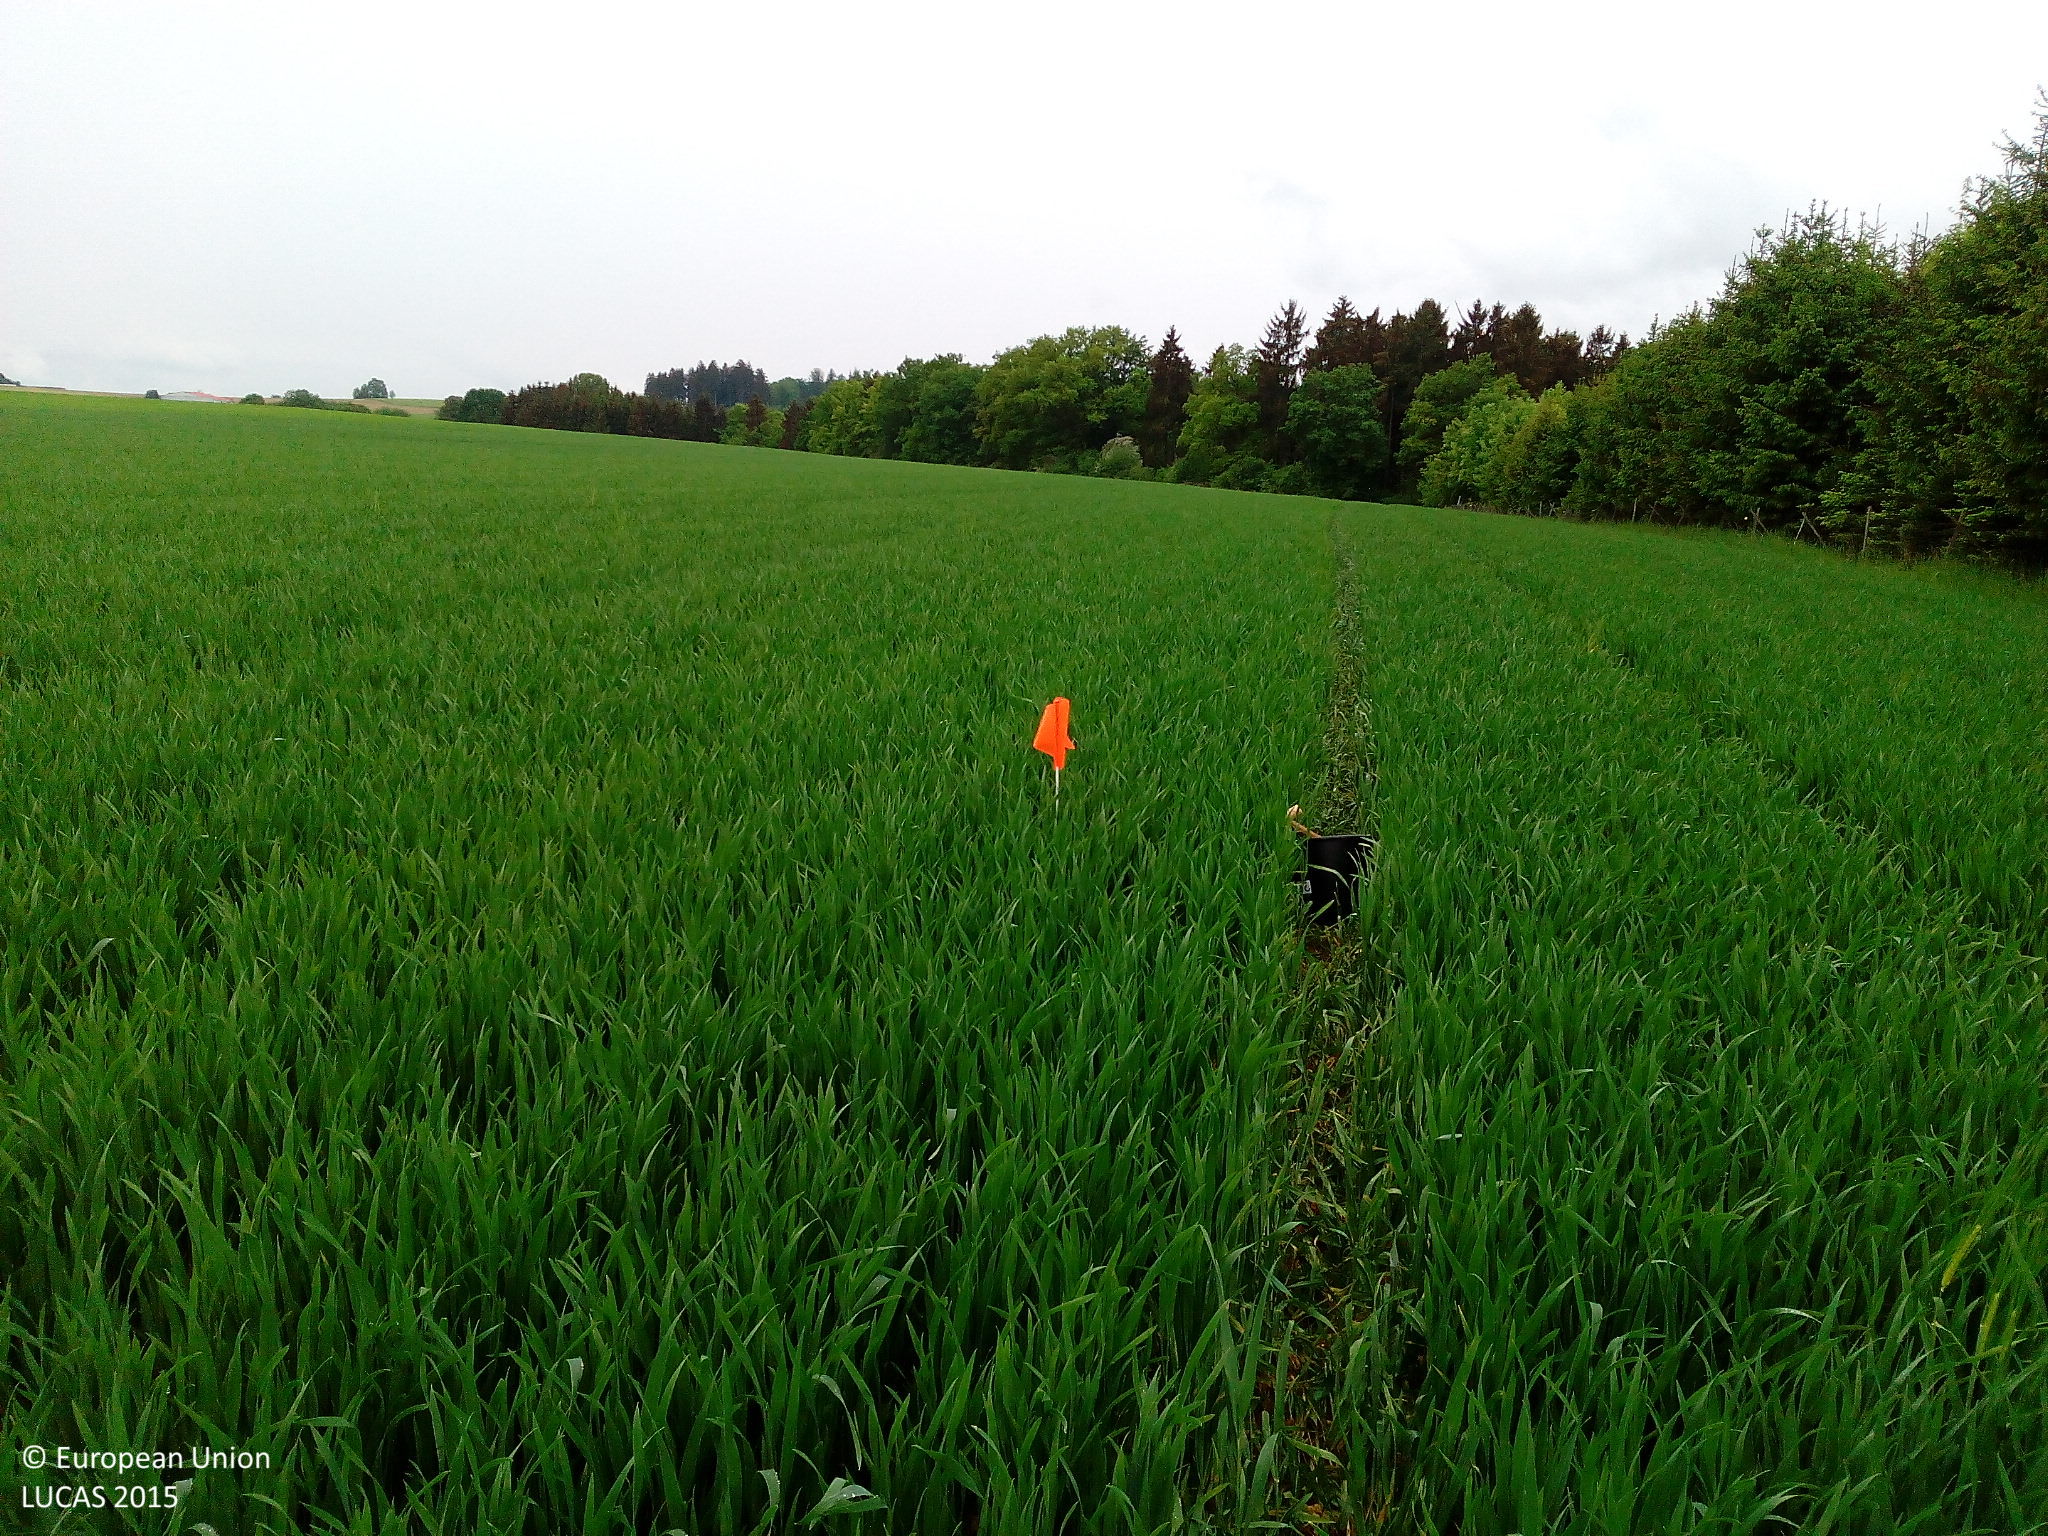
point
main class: Cropland
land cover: Common wheat
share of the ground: > 75 %
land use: Agriculture (excluding fallow land and kitchen gardens)
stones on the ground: < 10 %
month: May
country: DE
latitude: 49.2739
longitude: 11.5801
